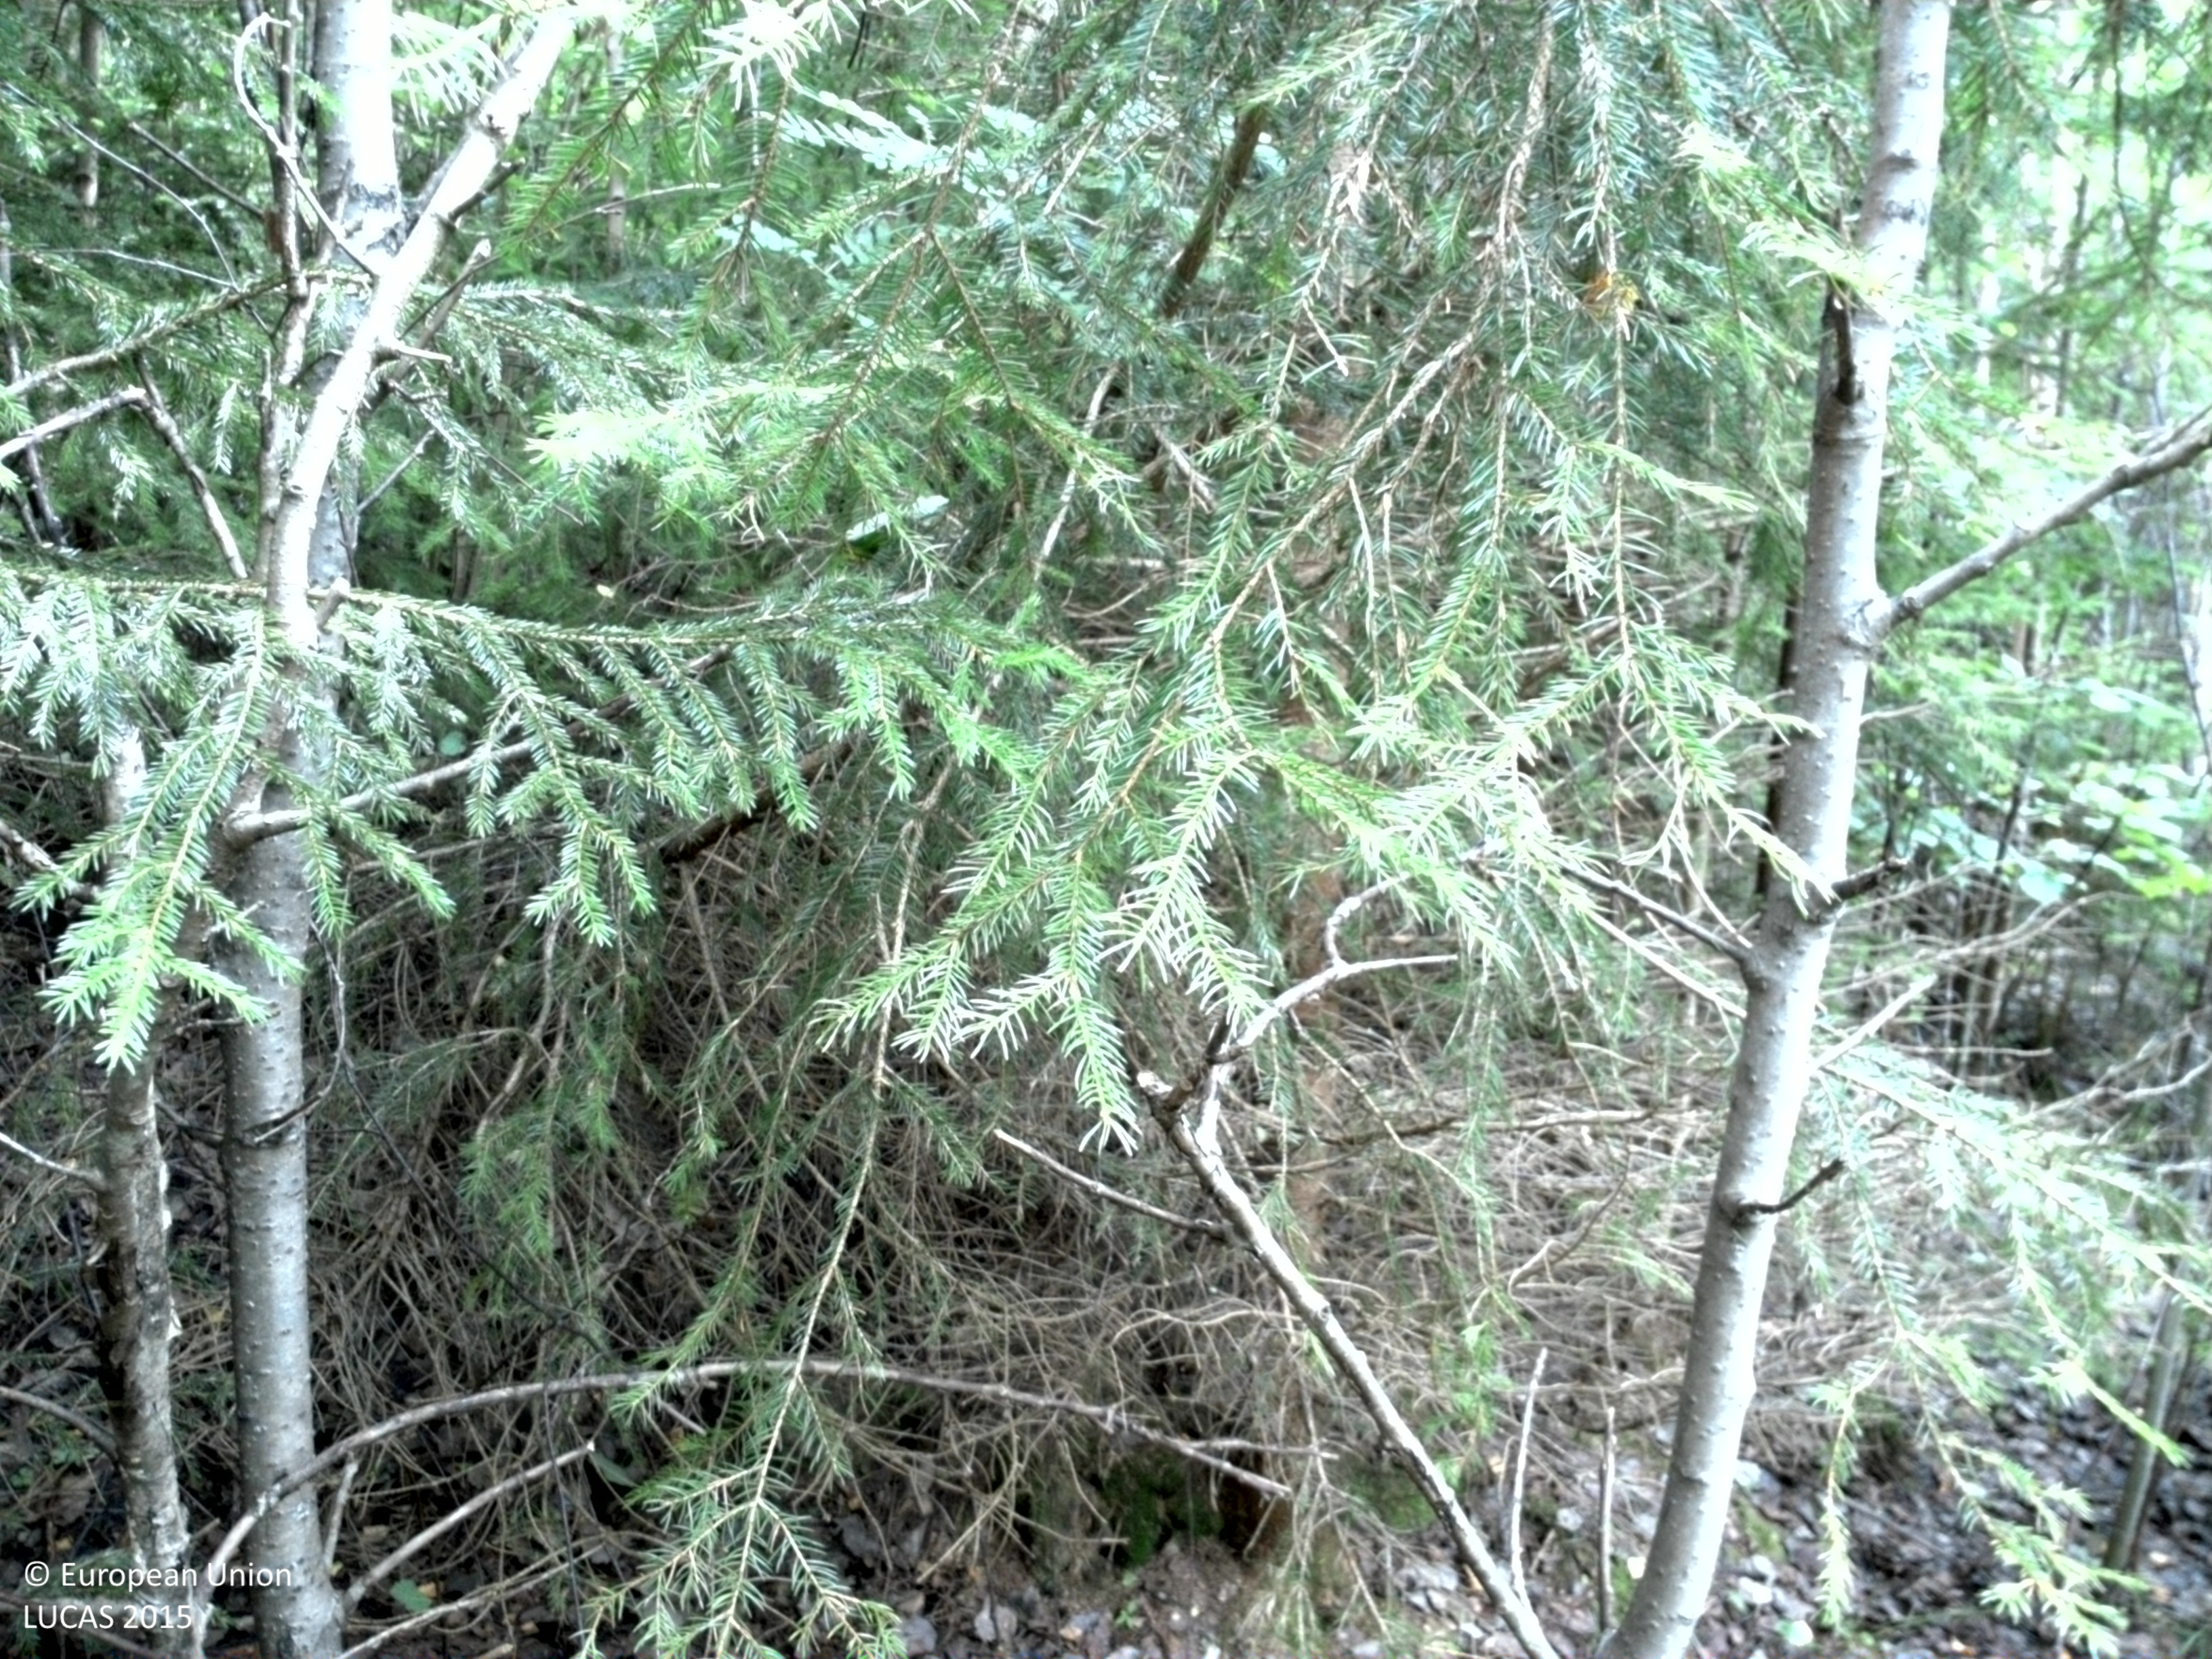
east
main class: Woodland
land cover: Spruce dominated mixed woodland
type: boreal forest
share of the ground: 50 - 75 %
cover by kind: coniferous forest trees 45 %, broadleaved forest trees 25 %, herbaceous plants 25 %, lichens and mosses 5 %
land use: Forestry
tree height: > 5 m
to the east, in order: Spruce dominated mixed woodland; Pine dominated coniferous woodland; Other coniferous woodland; Pine dominated coniferous woodland
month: July
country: SE
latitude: 58.8274
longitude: 14.5481
